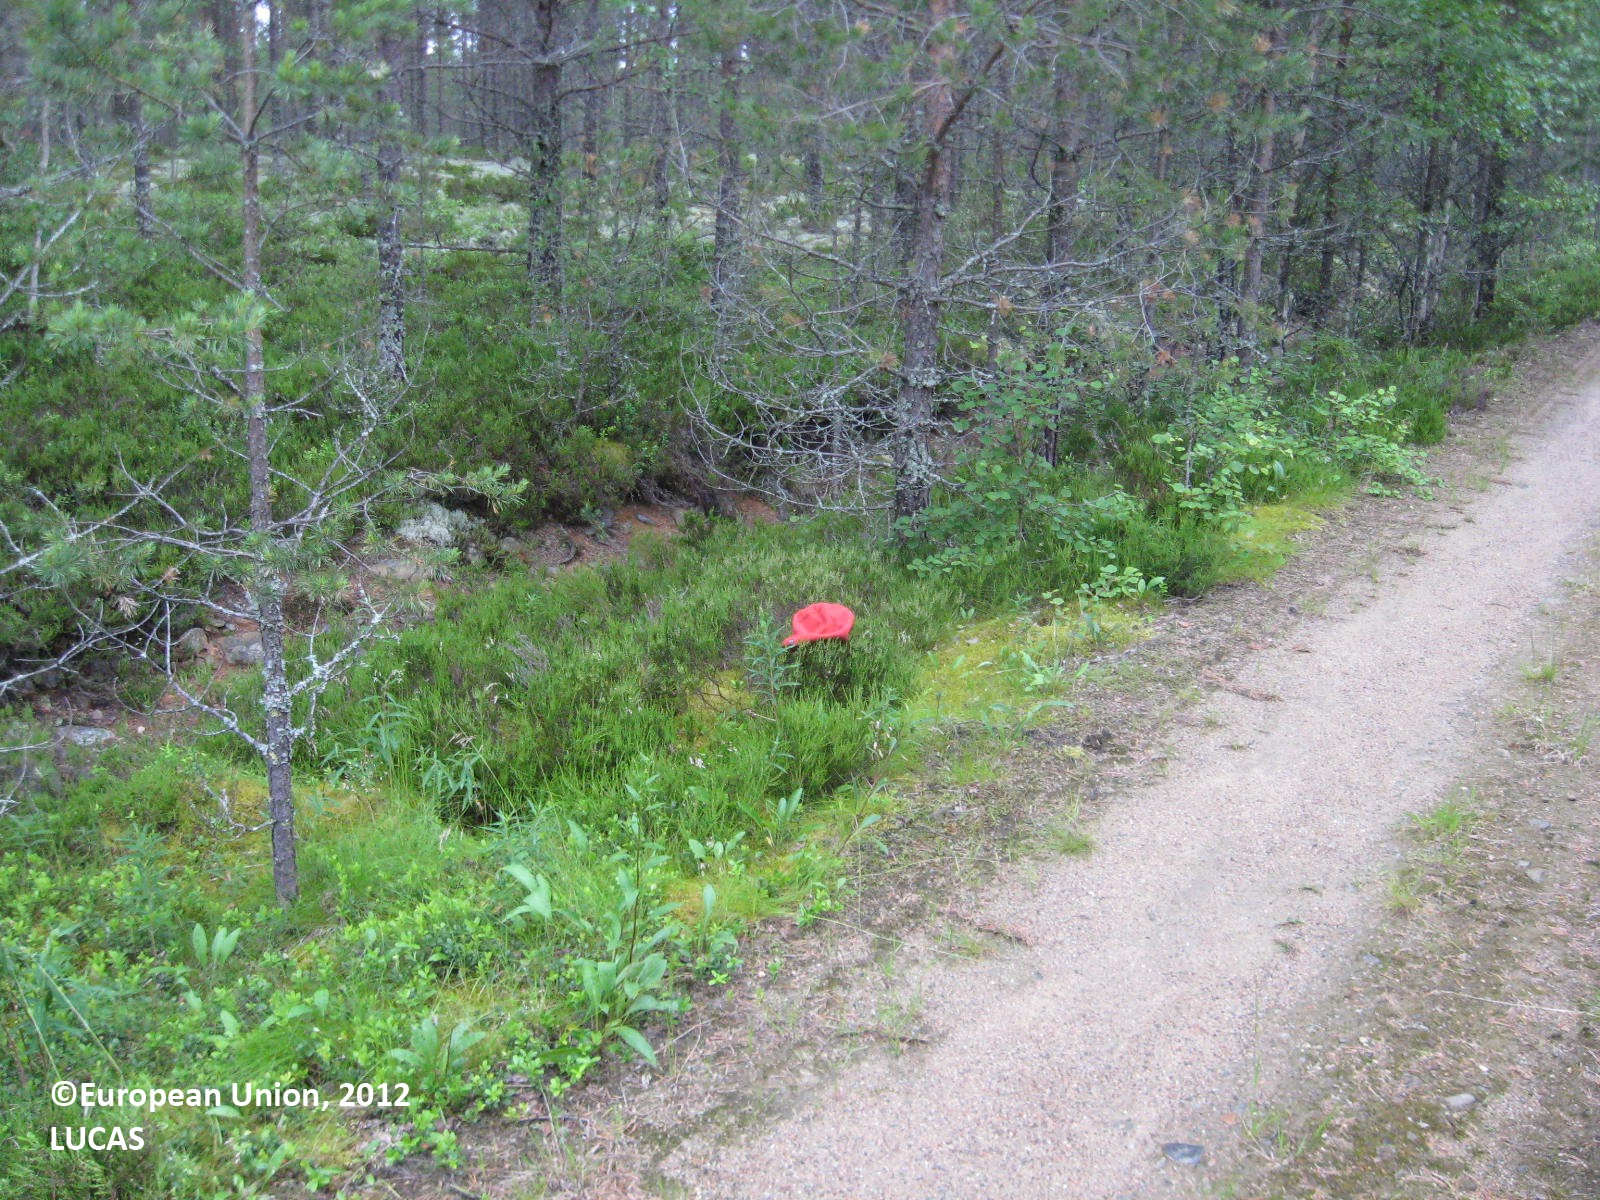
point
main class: Woodland
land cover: Pine dominated coniferous woodland
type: boreal forest
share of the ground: > 75 %
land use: Forestry
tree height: > 5 m
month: July
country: FI
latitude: 62.3473
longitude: 22.4755
